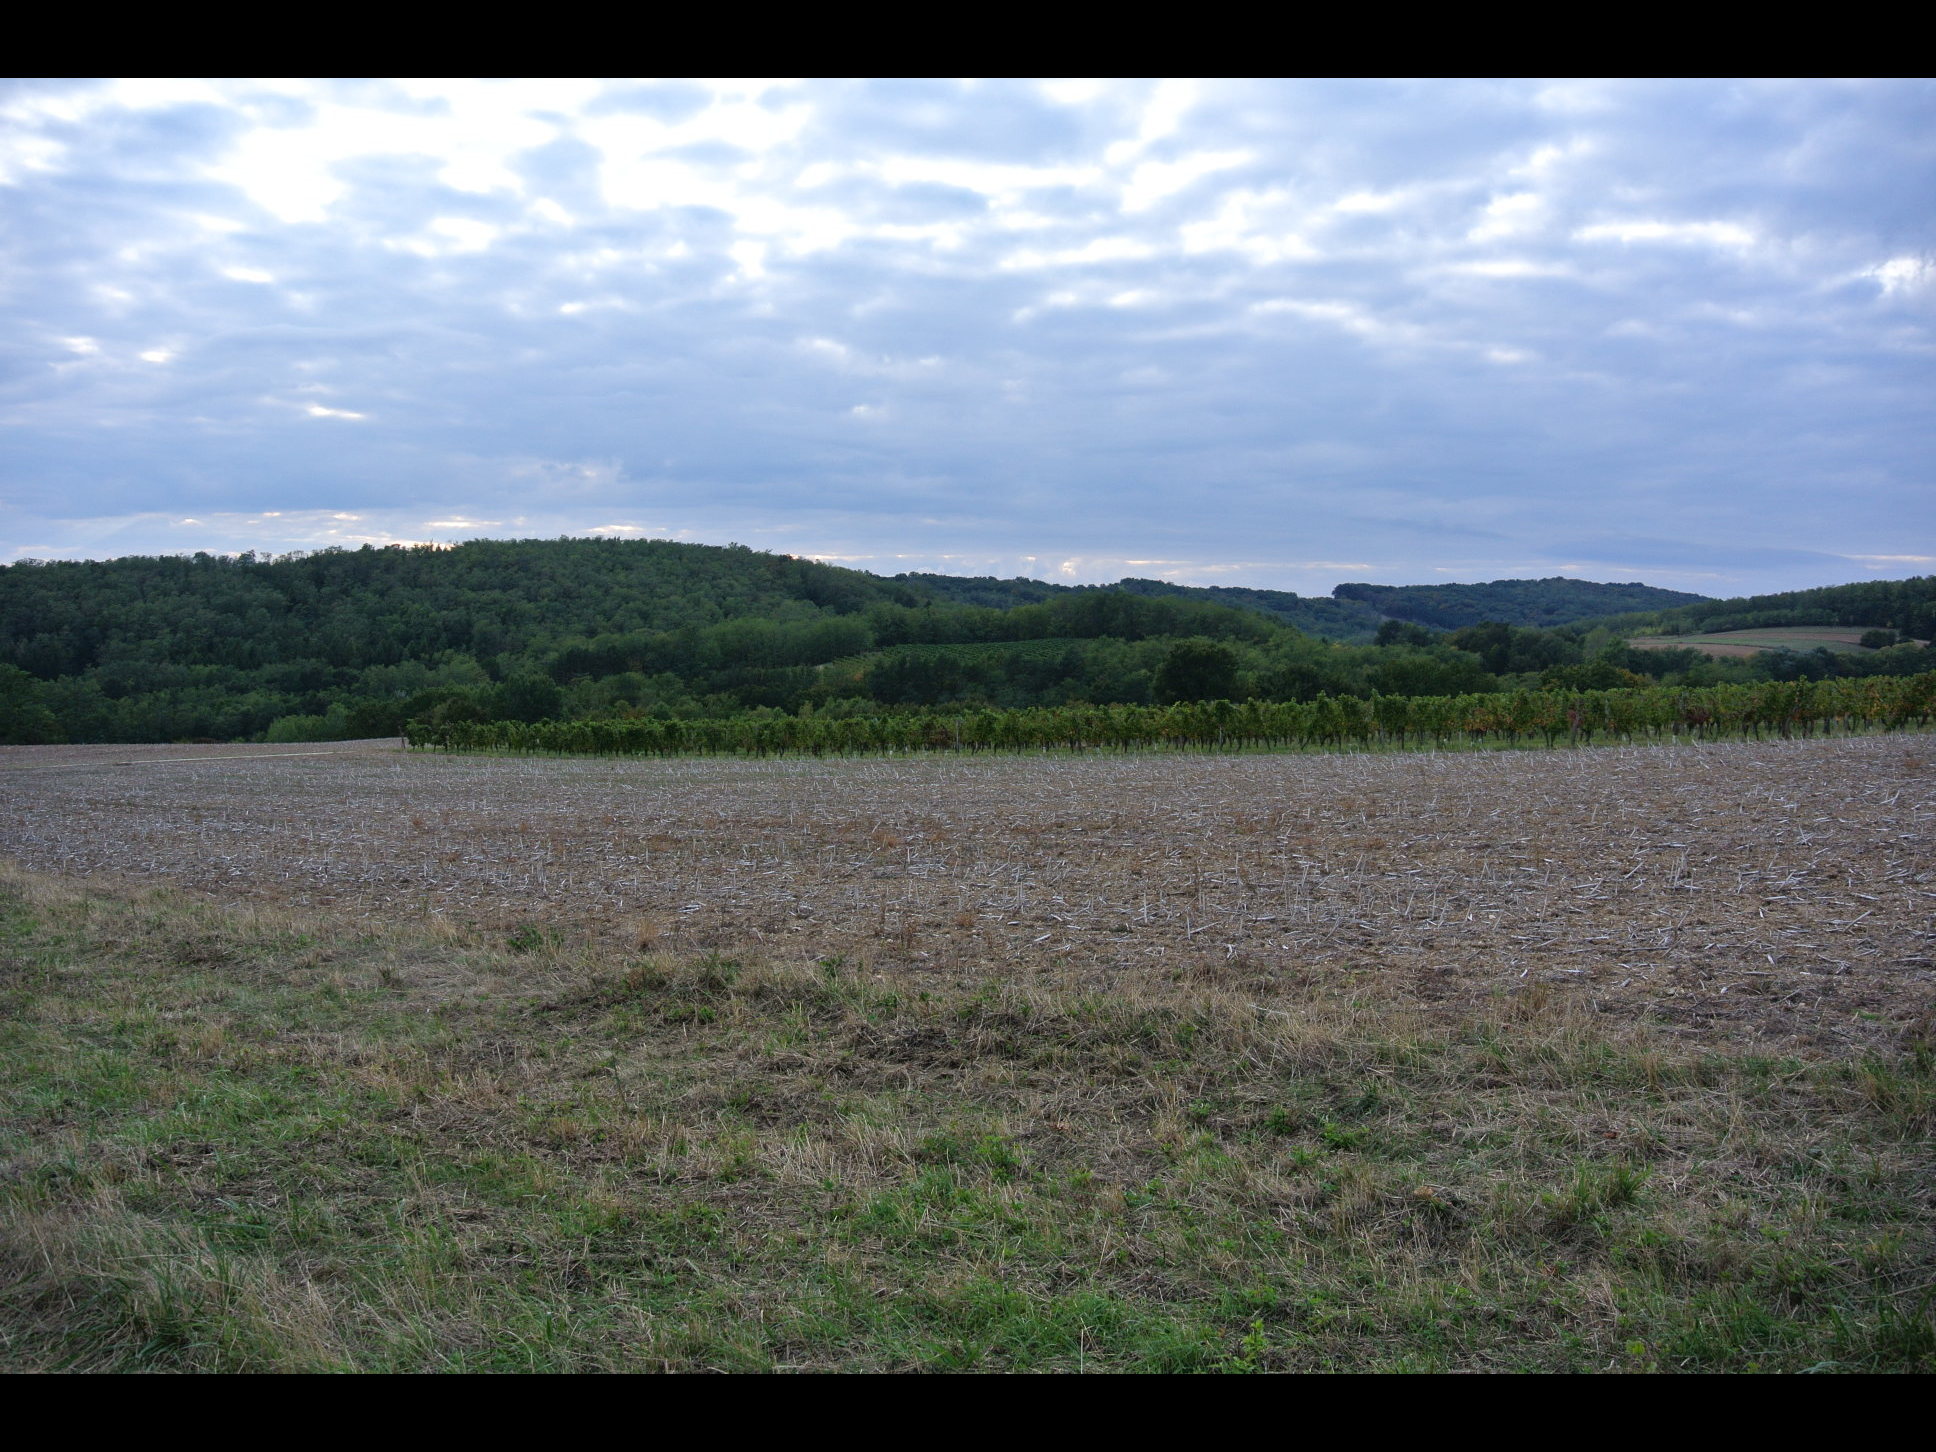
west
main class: Grassland
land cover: Grassland without tree/shrub cover
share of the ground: > 75 %
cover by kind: herbaceous plants 100 %
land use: Agriculture (excluding fallow land and kitchen gardens)
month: September
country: AT
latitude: 47.6143
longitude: 16.5365
